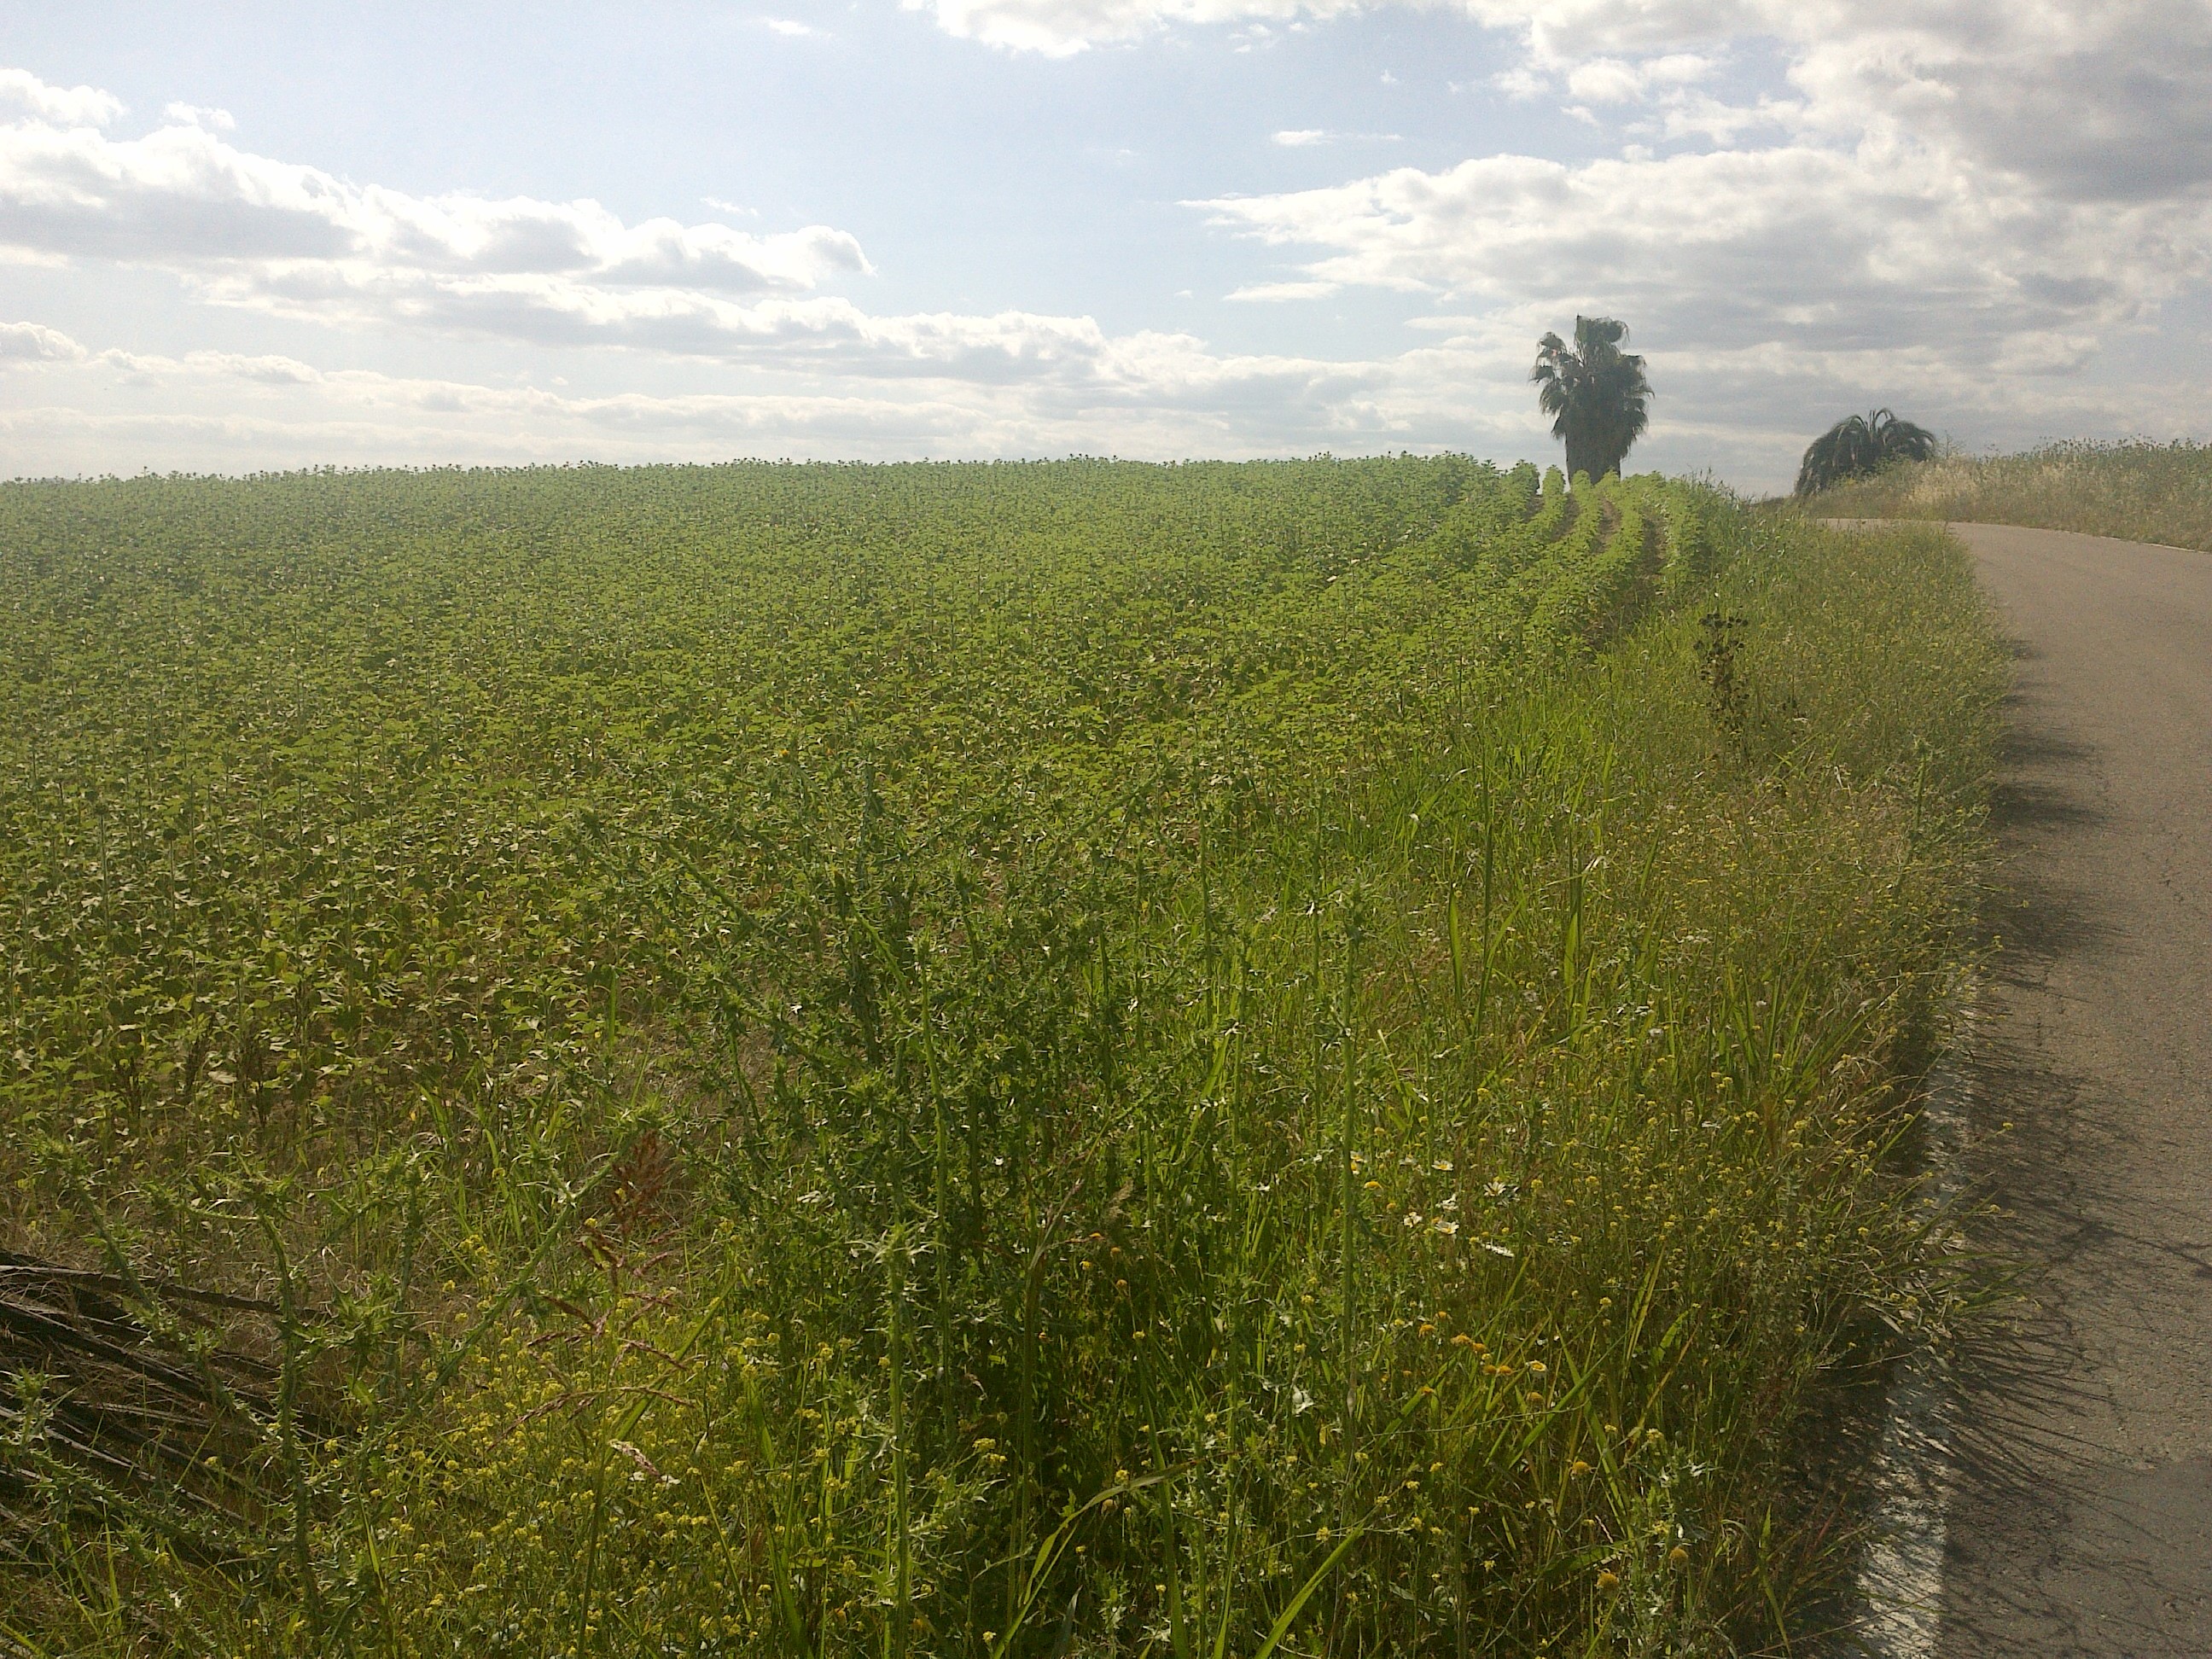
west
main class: Cropland
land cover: Sunflower
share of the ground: > 75 %
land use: Agriculture (excluding fallow land and kitchen gardens)
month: May
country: ES
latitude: 37.8093
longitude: -5.1825
